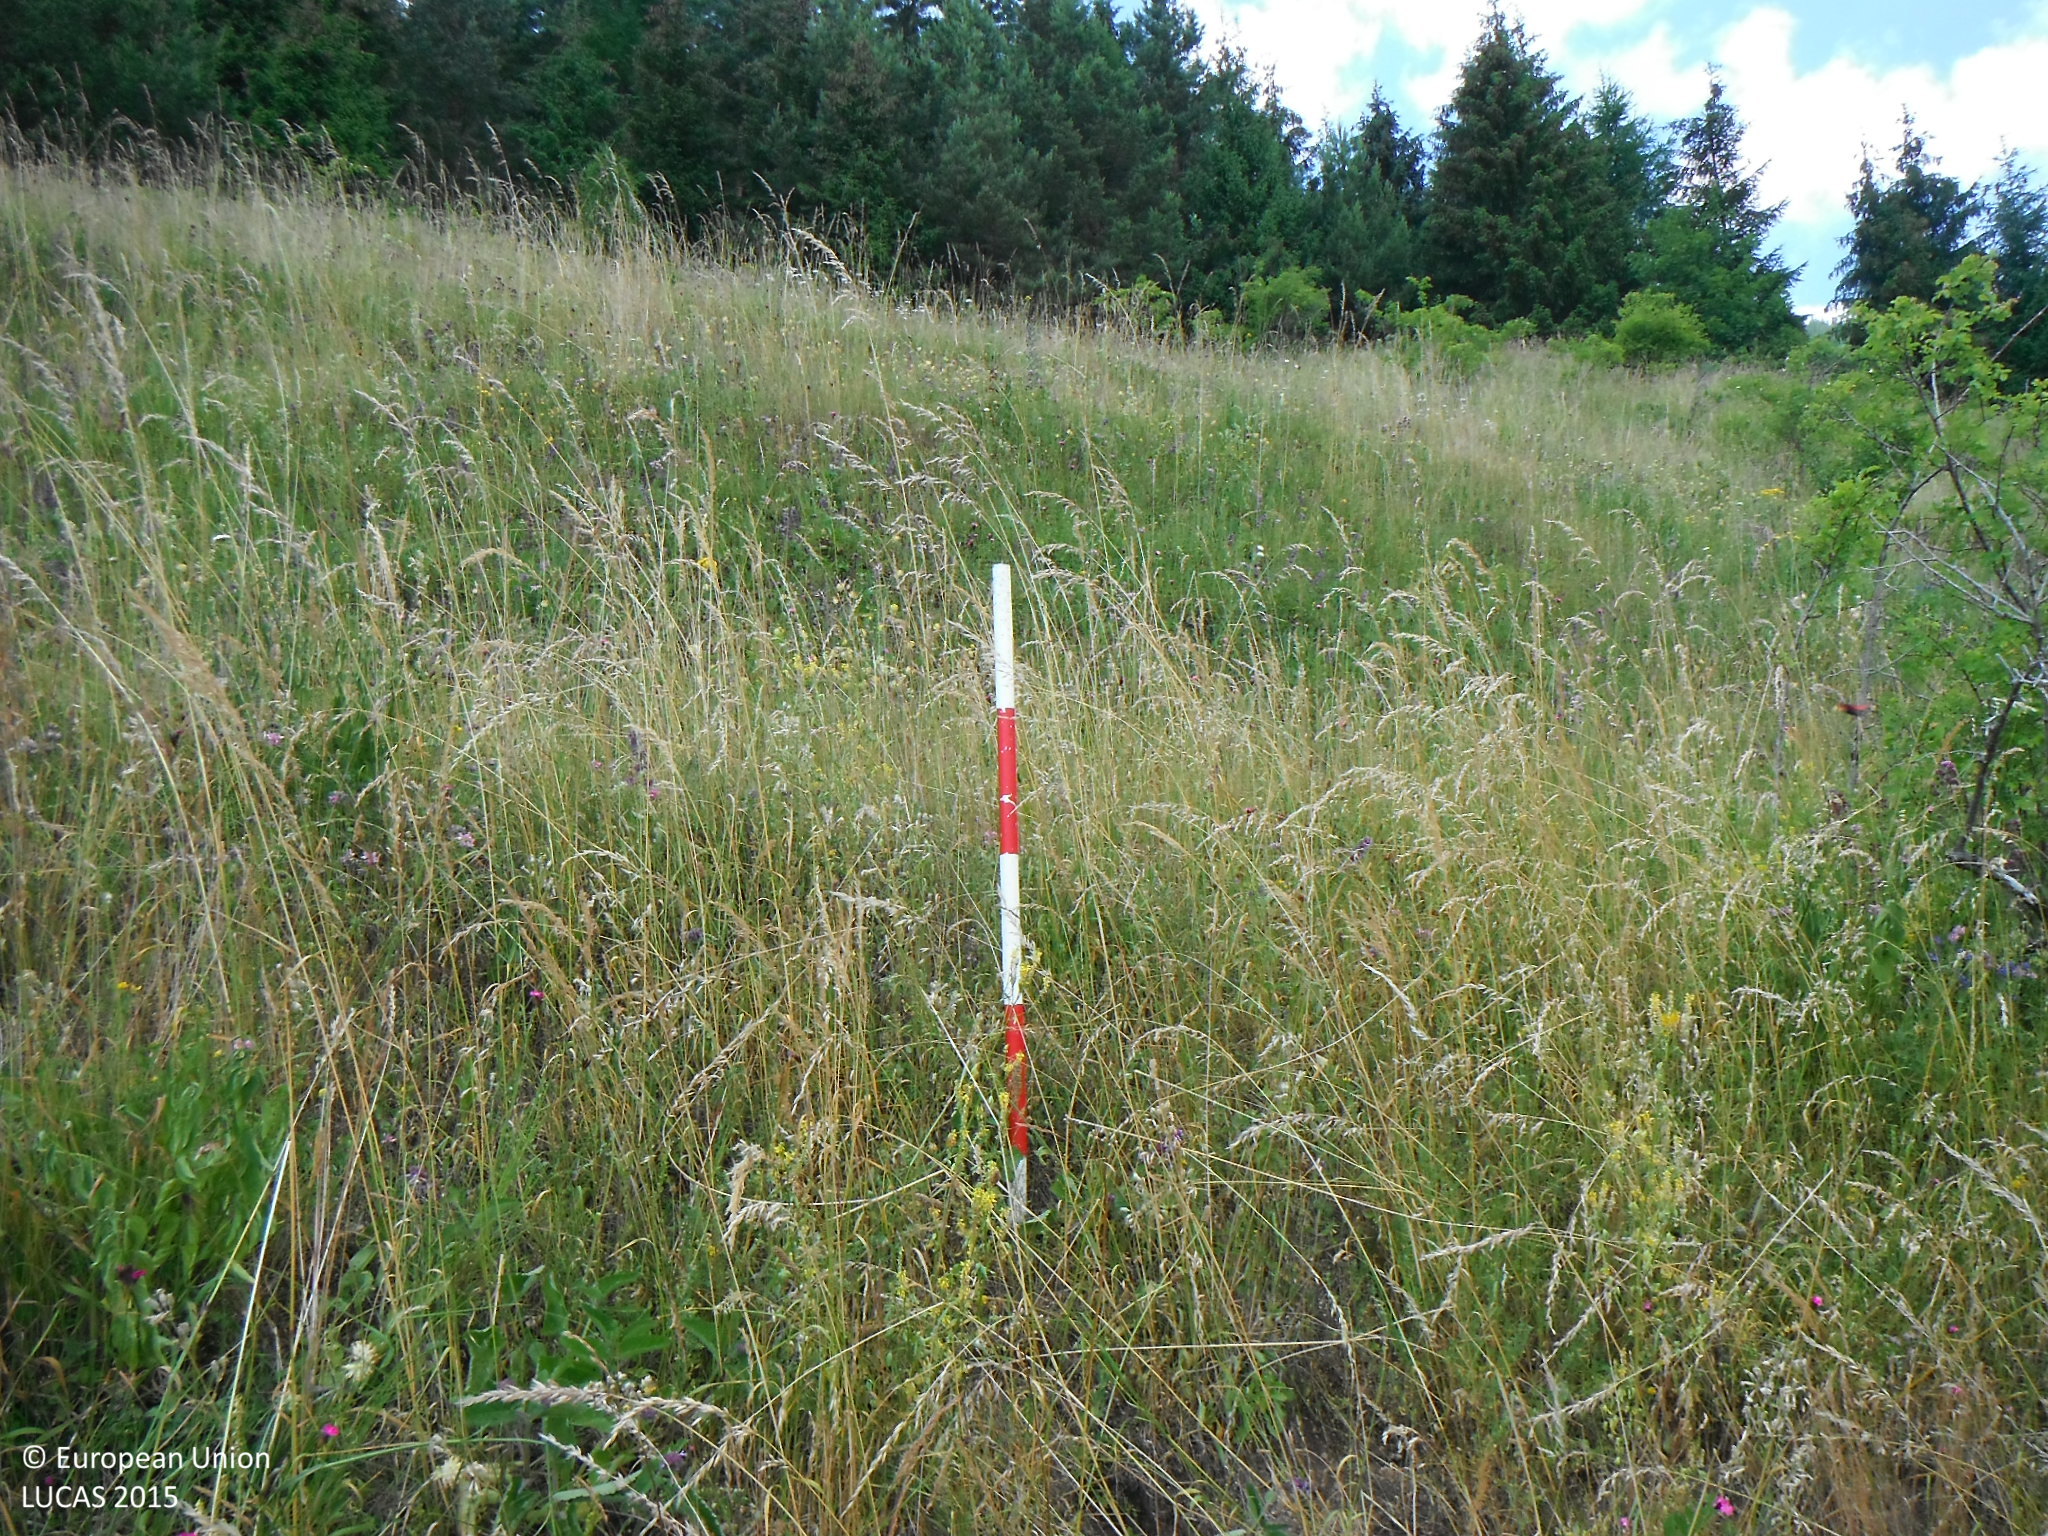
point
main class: Grassland
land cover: Grassland with sparse tree/shrub cover
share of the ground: > 75 %
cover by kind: herbaceous plants 90 %, broadleaved forest trees 5 %, shrubs 5 %
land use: Agriculture (excluding fallow land and kitchen gardens)
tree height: < 5 m
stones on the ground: 25 - 50 %
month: July
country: SK
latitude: 49.1684
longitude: 19.5312
